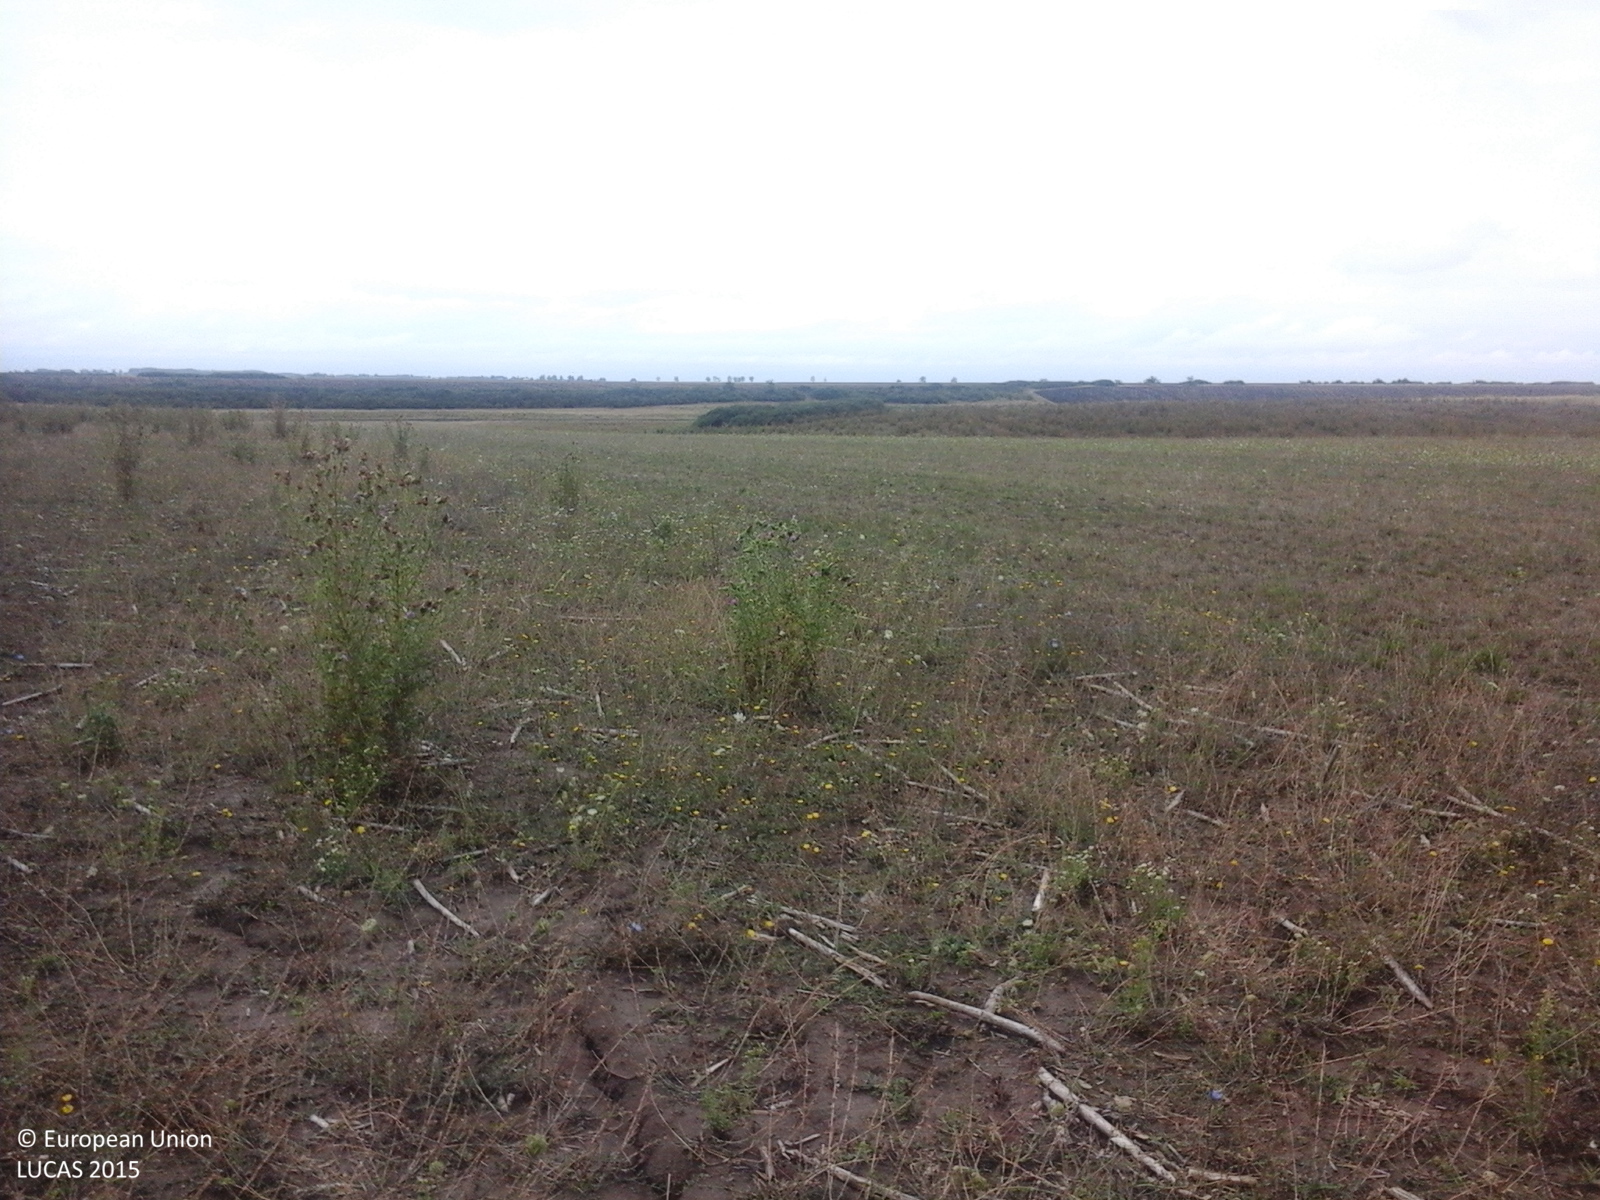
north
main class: Grassland
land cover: Spontaneously vegetated surfaces
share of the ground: > 75 %
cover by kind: herbaceous plants 100 %
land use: Agriculture (excluding fallow land and kitchen gardens)
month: August
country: RO
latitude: 45.5623
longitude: 21.5251
